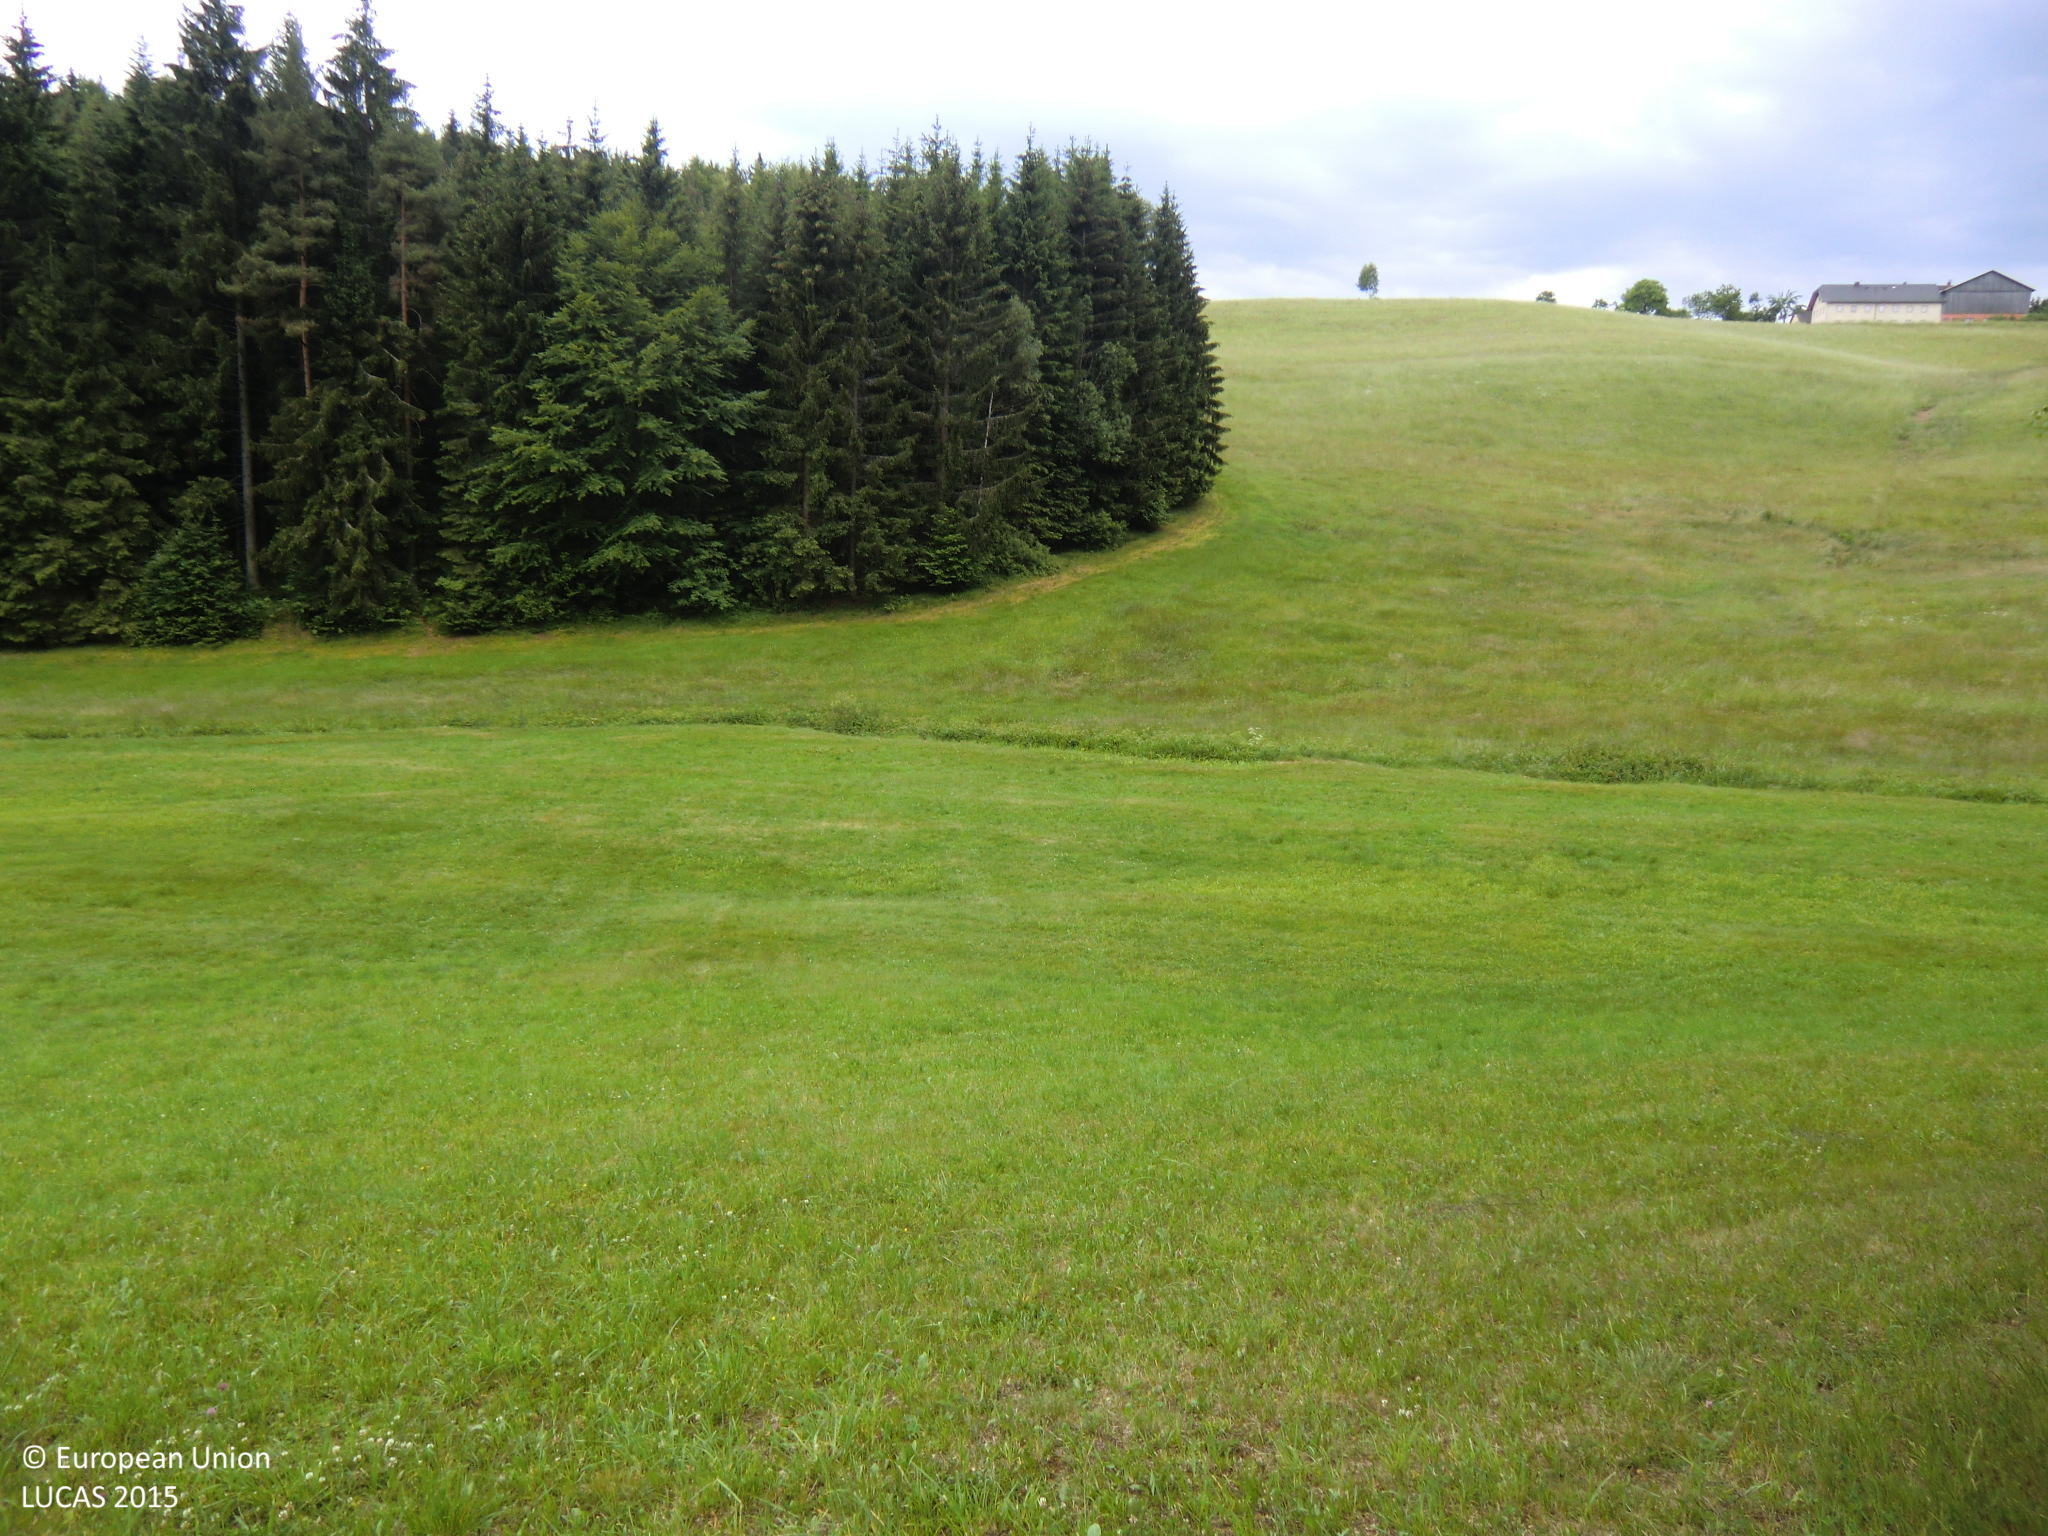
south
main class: Grassland
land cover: Grassland without tree/shrub cover
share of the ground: > 75 %
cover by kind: herbaceous plants 70 %, unconsolidated bare surface 30 %
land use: Agriculture (excluding fallow land and kitchen gardens)
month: June
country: AT
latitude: 48.4973
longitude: 14.8054
